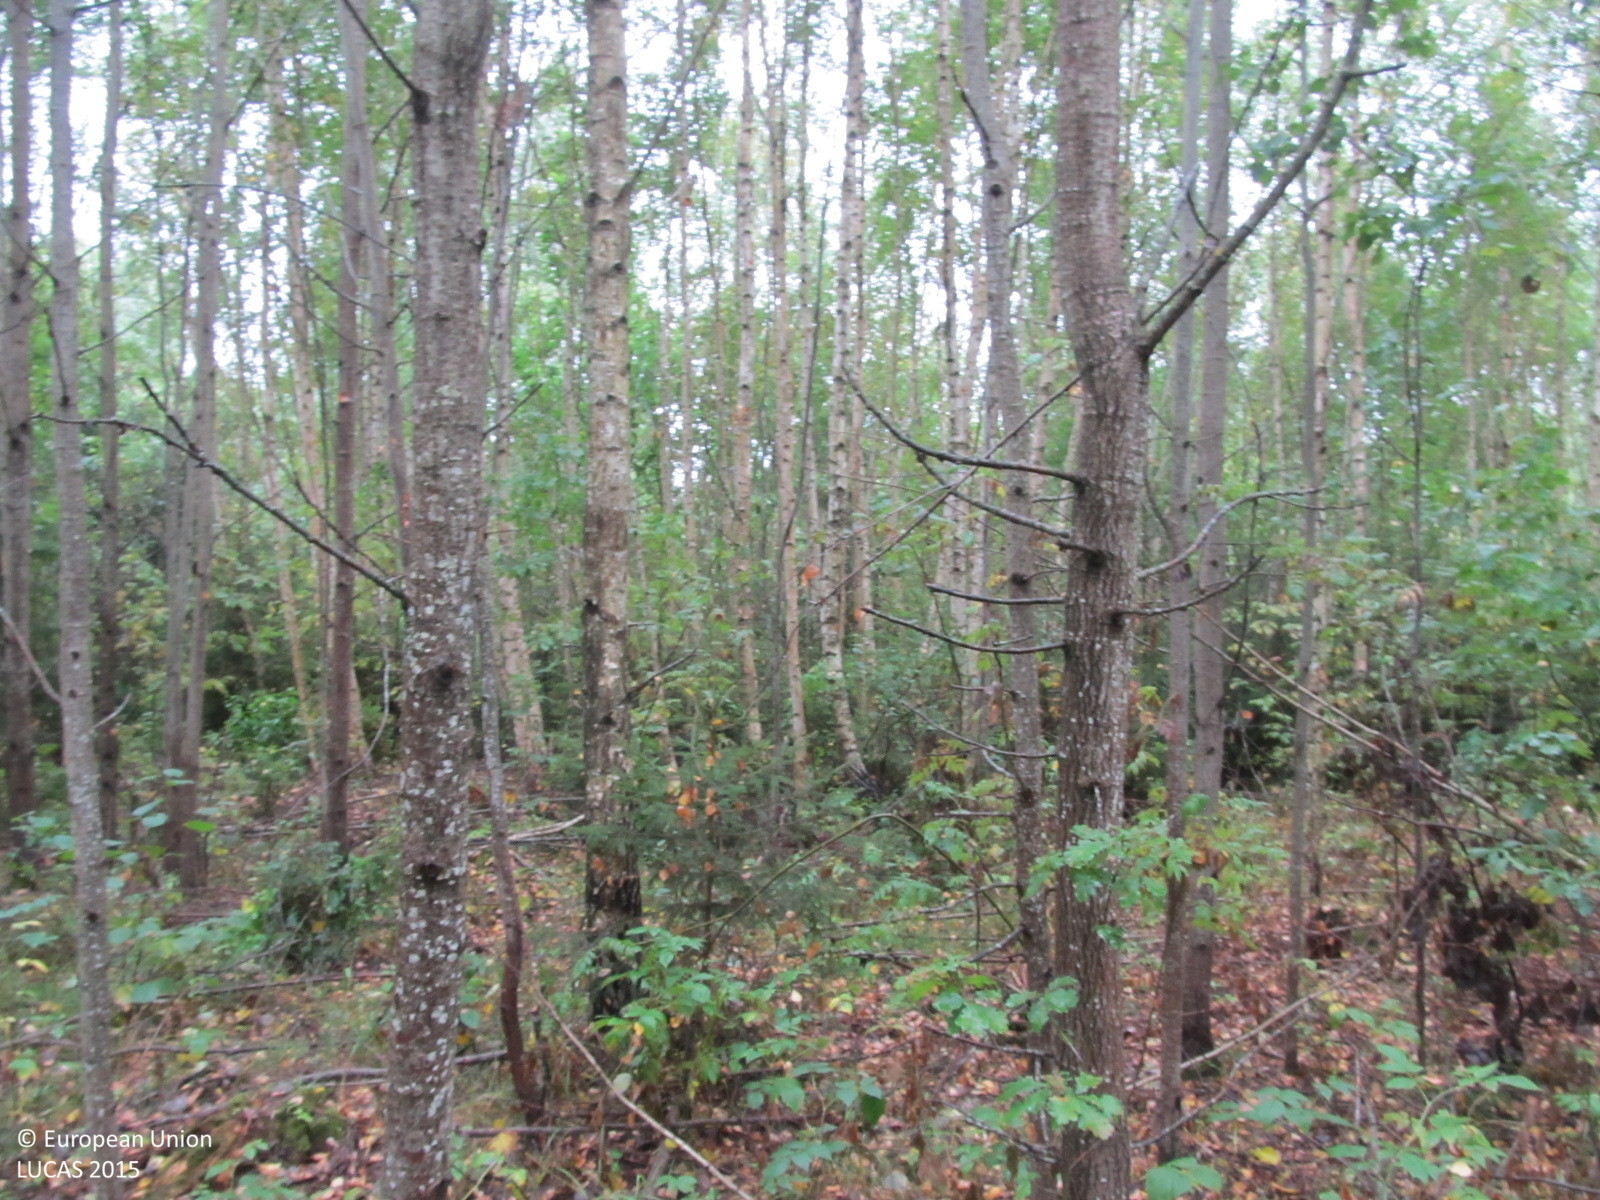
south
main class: Woodland
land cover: Broadleaved woodland
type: non-riverine alder, birch or aspen forest
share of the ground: > 75 %
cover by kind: broadleaved forest trees 75 %, coniferous forest trees 5 %, shrubs 5 %, herbaceous plants 5 %, lichens and mosses 5 %, unconsolidated bare surface 5 %
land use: Forestry
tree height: > 5 m
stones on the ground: < 10 %
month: September
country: LT
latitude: 55.9883
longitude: 22.9062
